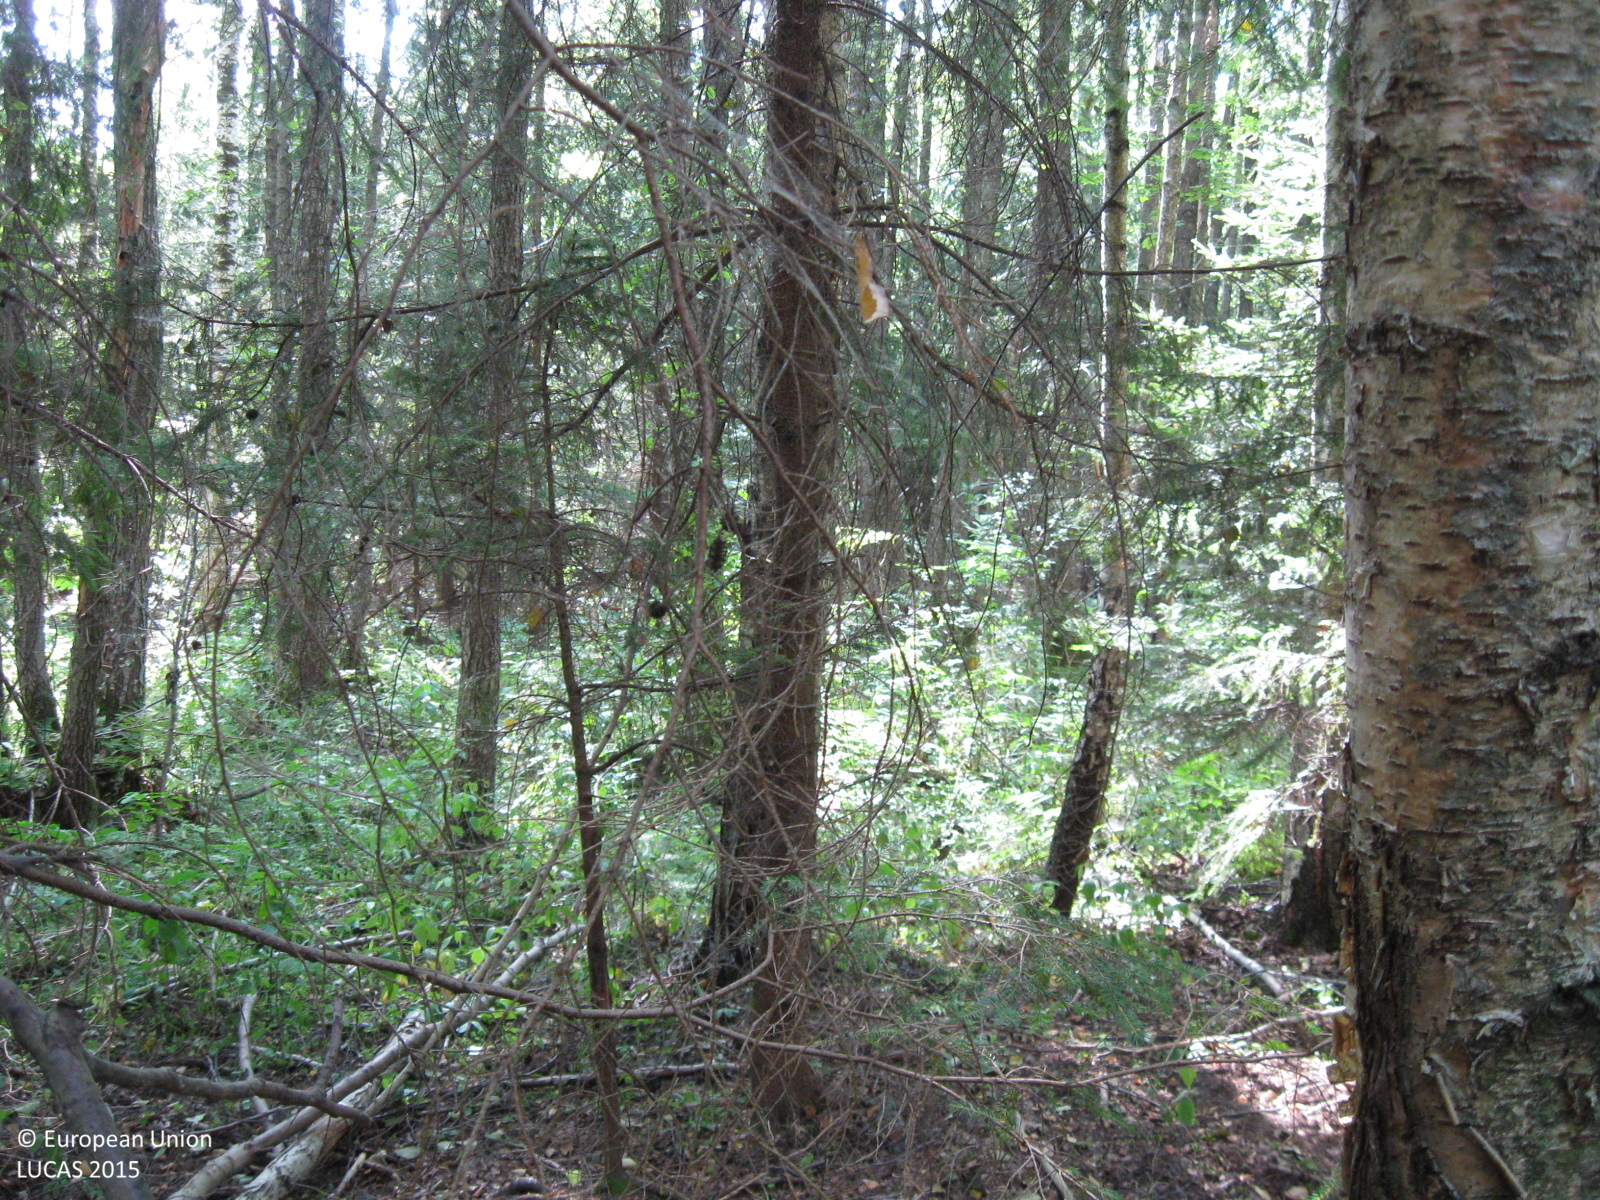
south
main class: Woodland
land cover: Spruce dominated mixed woodland
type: hemiboreal forest and nemoral coniferous forest and mixed broadleaved-coniferous forest
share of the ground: > 75 %
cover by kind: broadleaved forest trees 65 %, coniferous forest trees 30 %, herbaceous plants 5 %
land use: Forestry
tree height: > 5 m
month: August
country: LT
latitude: 55.2106
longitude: 22.8445
